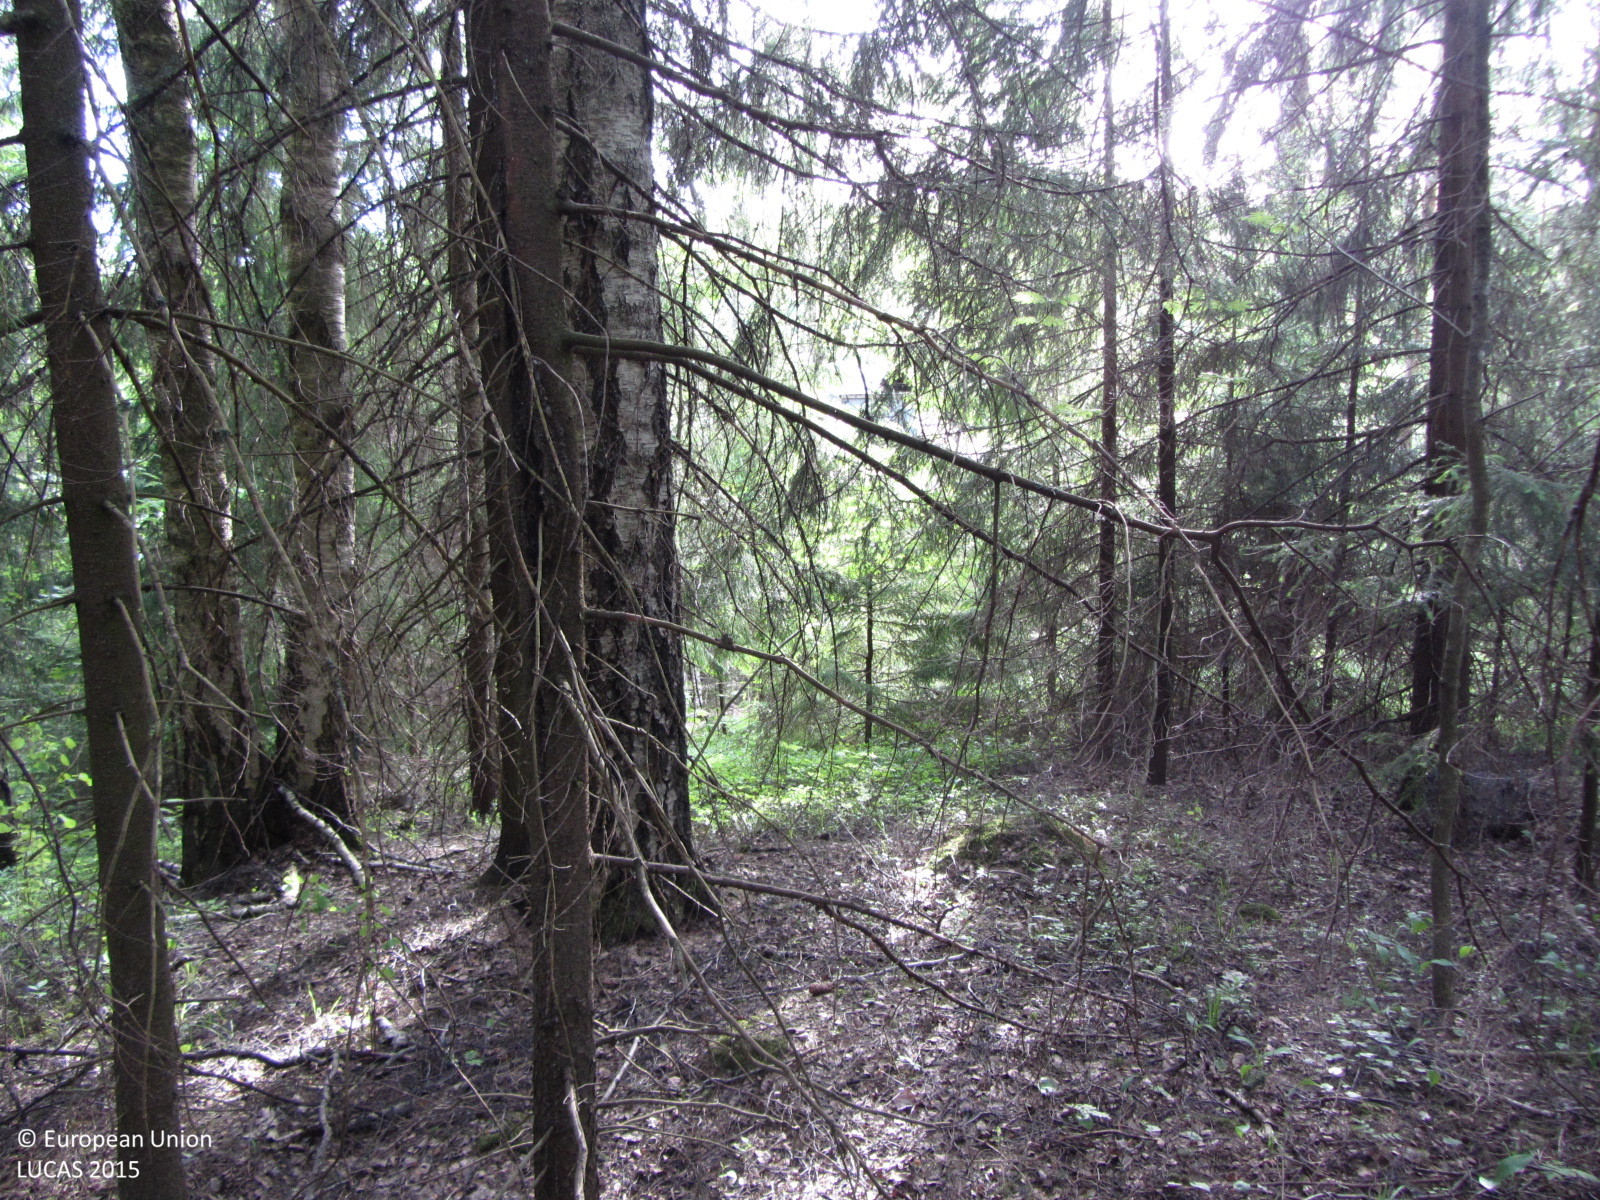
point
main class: Woodland
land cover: Spruce dominated mixed woodland
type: boreal forest
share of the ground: 50 - 75 %
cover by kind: coniferous forest trees 40 %, broadleaved forest trees 20 %, herbaceous plants 20 %, unconsolidated bare surface 20 %
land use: Residential
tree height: > 5 m
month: June
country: FI
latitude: 60.3149
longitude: 24.2402
